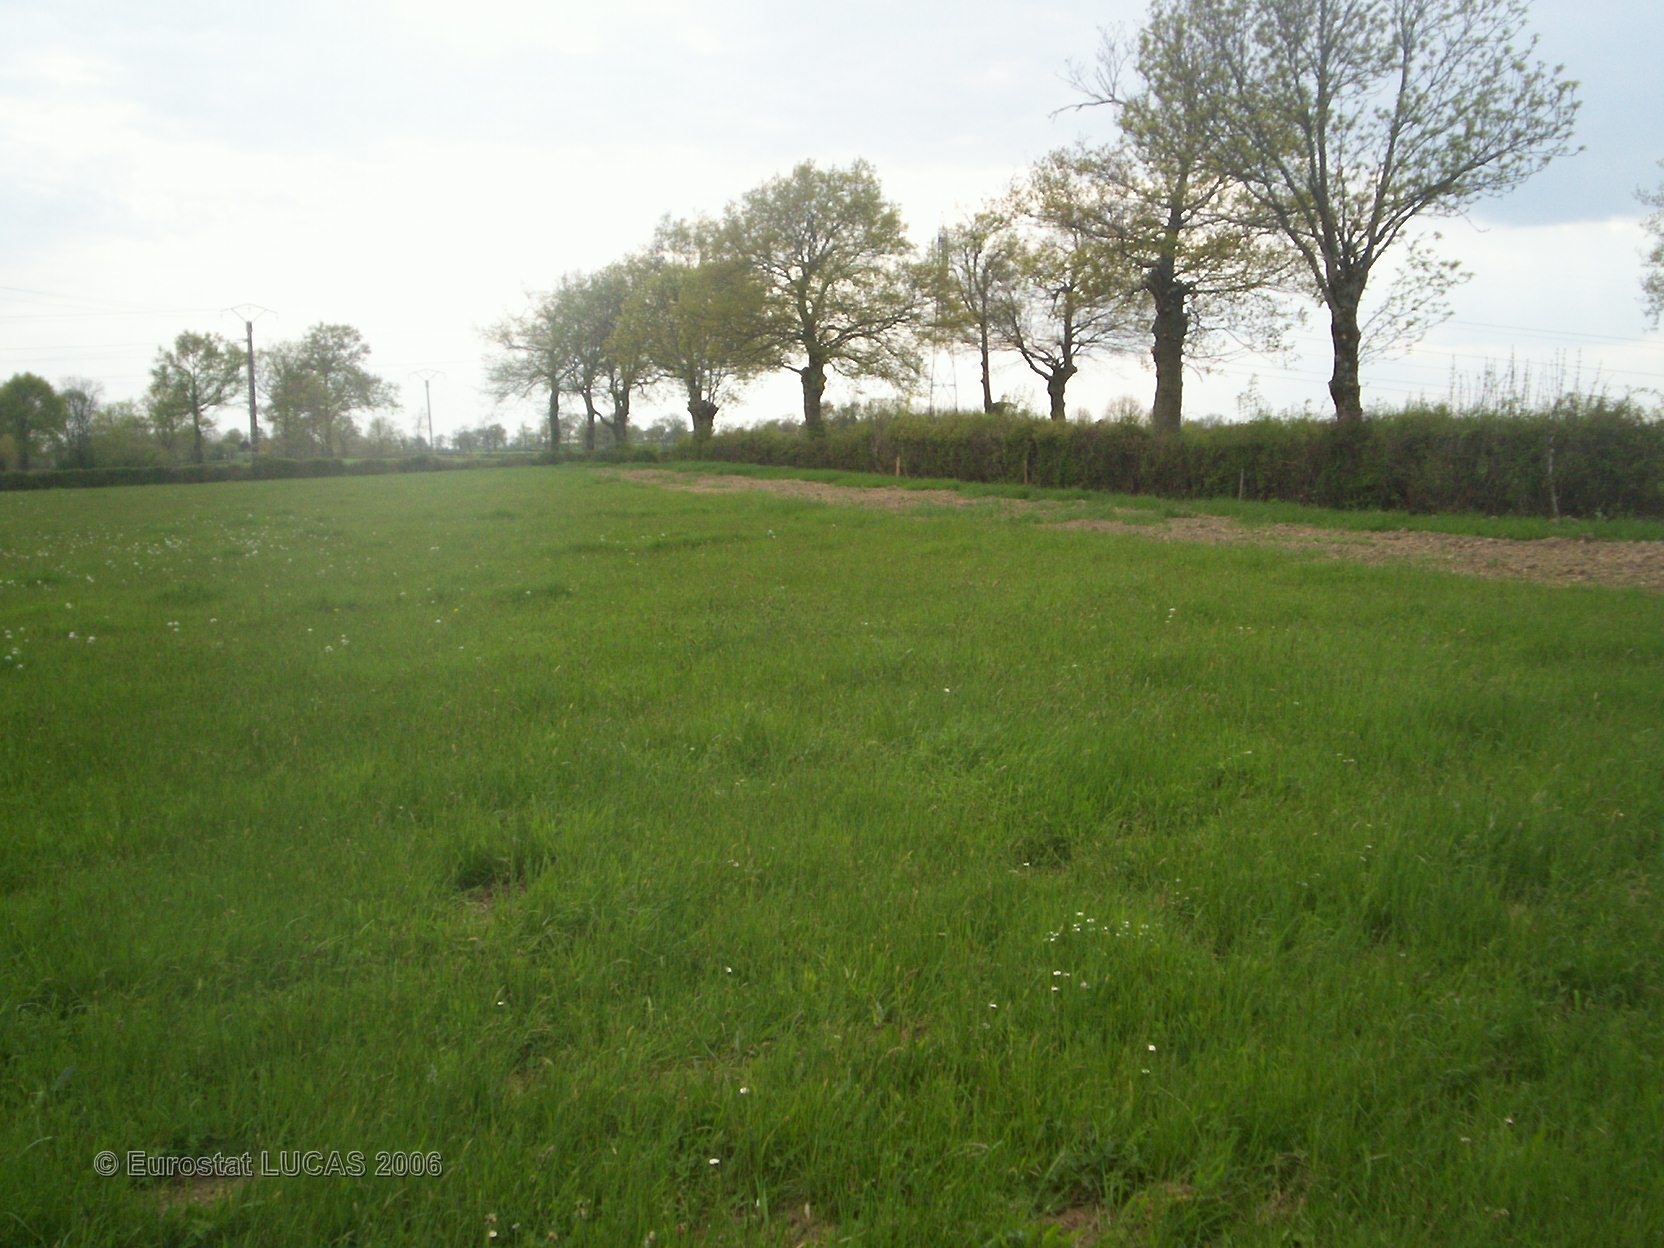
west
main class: Grassland
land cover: Grassland without tree/shrub cover
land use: Agriculture (excluding fallow land and kitchen gardens)
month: May
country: FR
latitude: 46.4380
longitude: 3.1387
